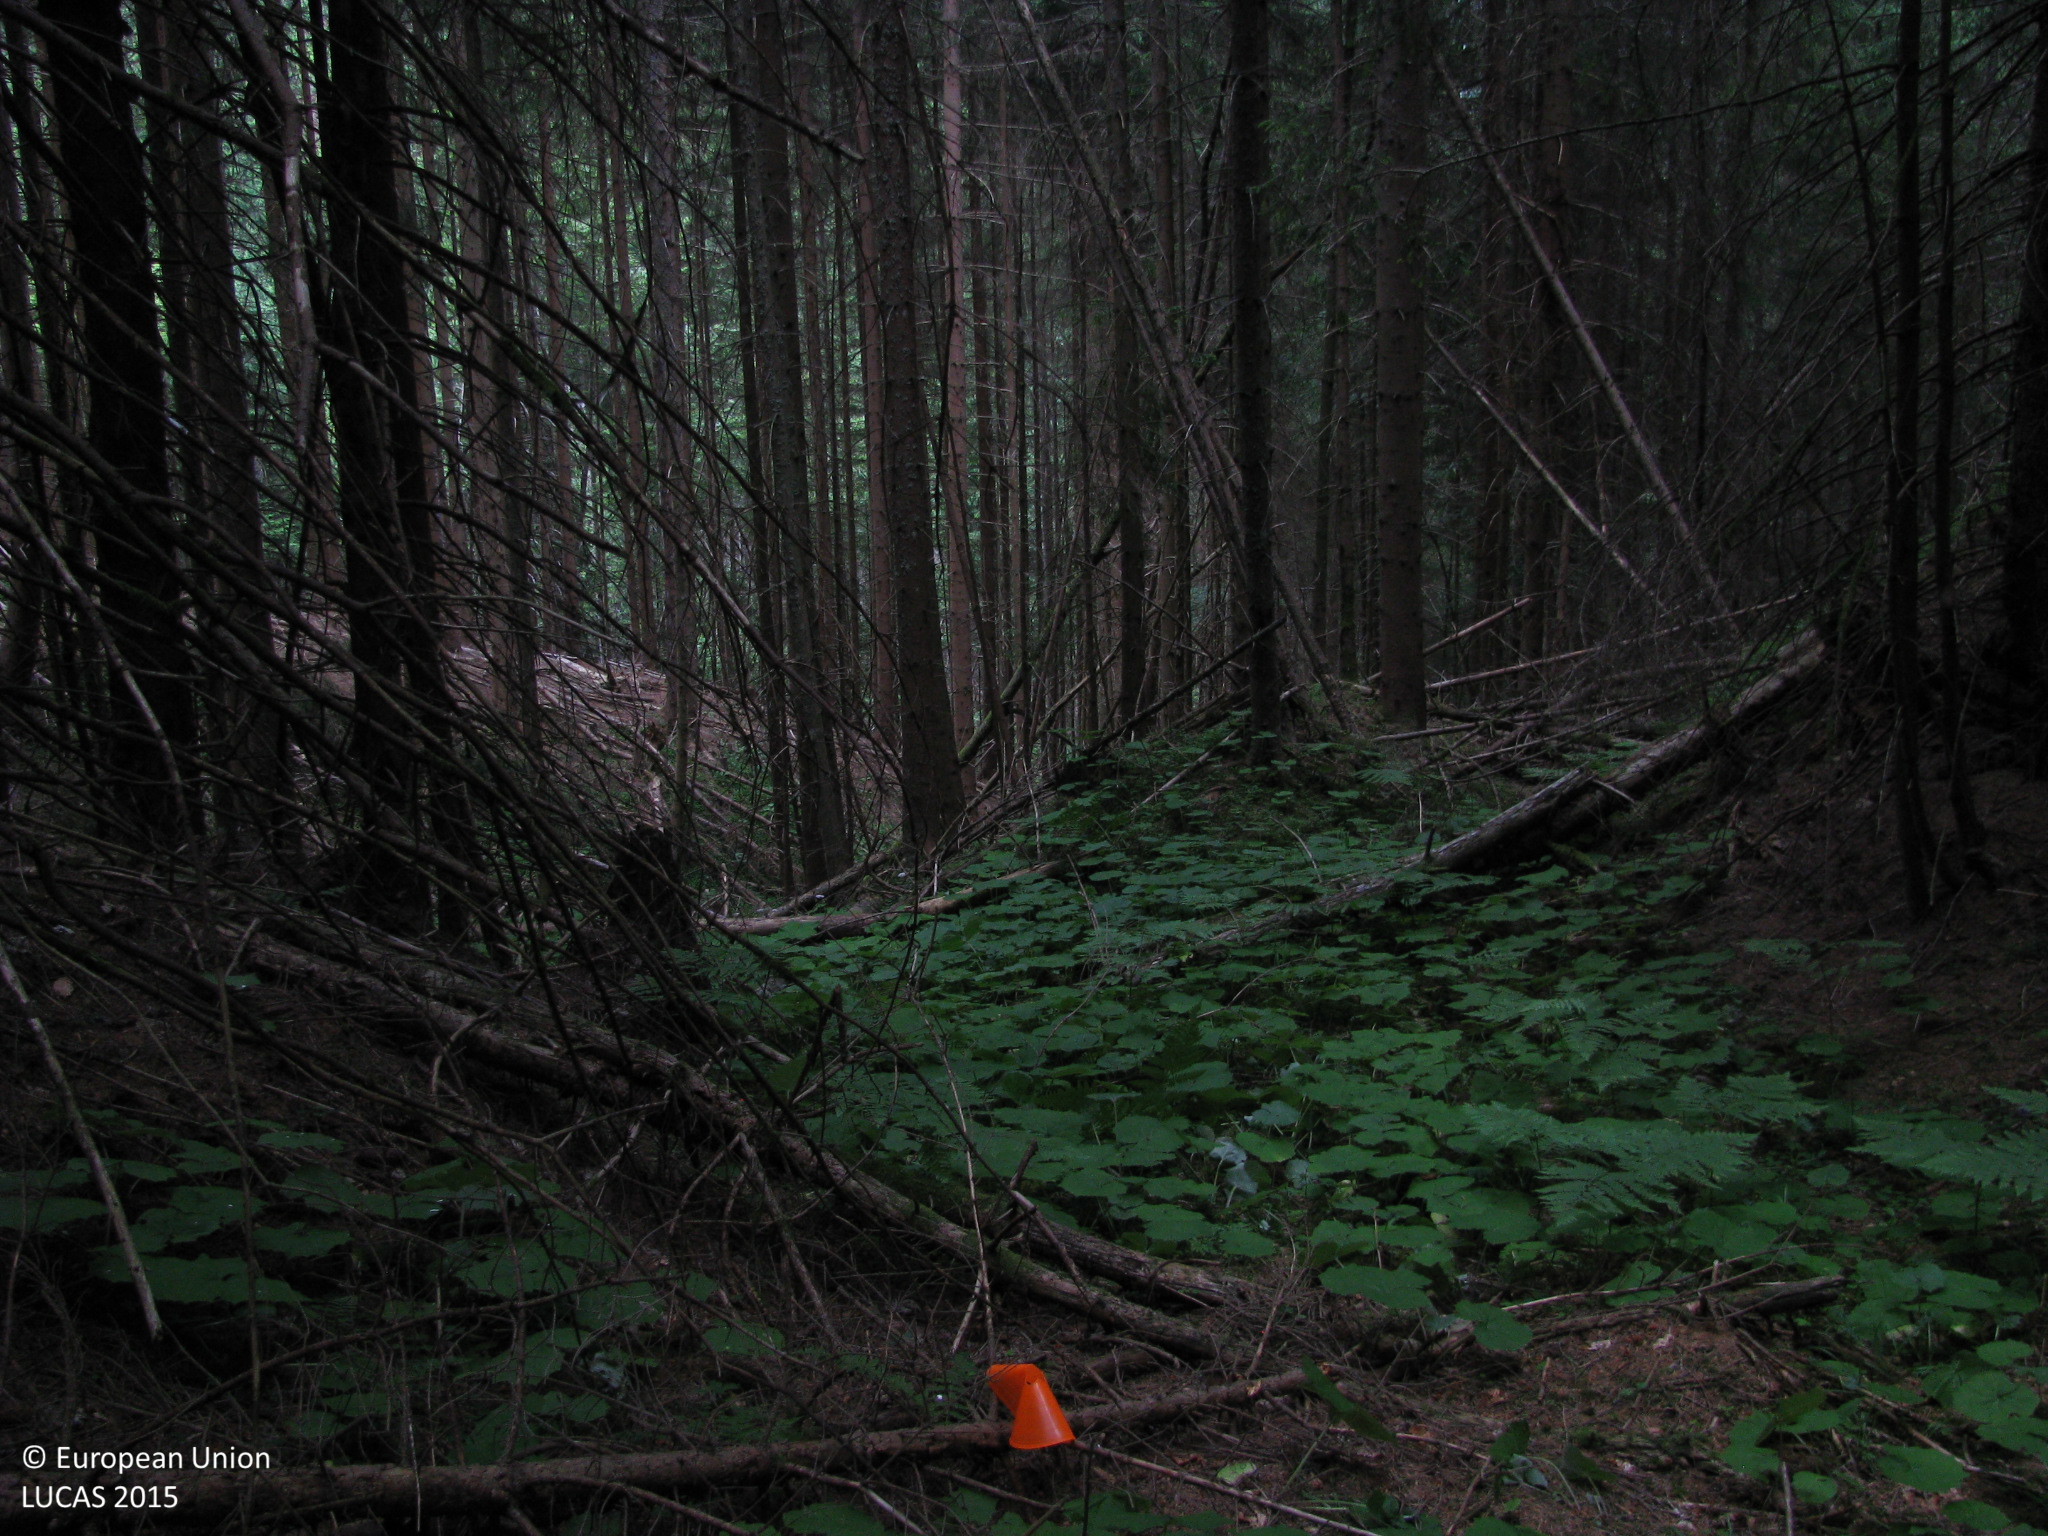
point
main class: Woodland
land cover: Spruce dominated coniferous woodland
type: alpine coniferous forest
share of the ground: > 75 %
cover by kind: coniferous forest trees 95 %, herbaceous plants 5 %
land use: Forestry
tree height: > 5 m
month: June
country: AT
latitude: 47.4357
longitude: 14.7594
